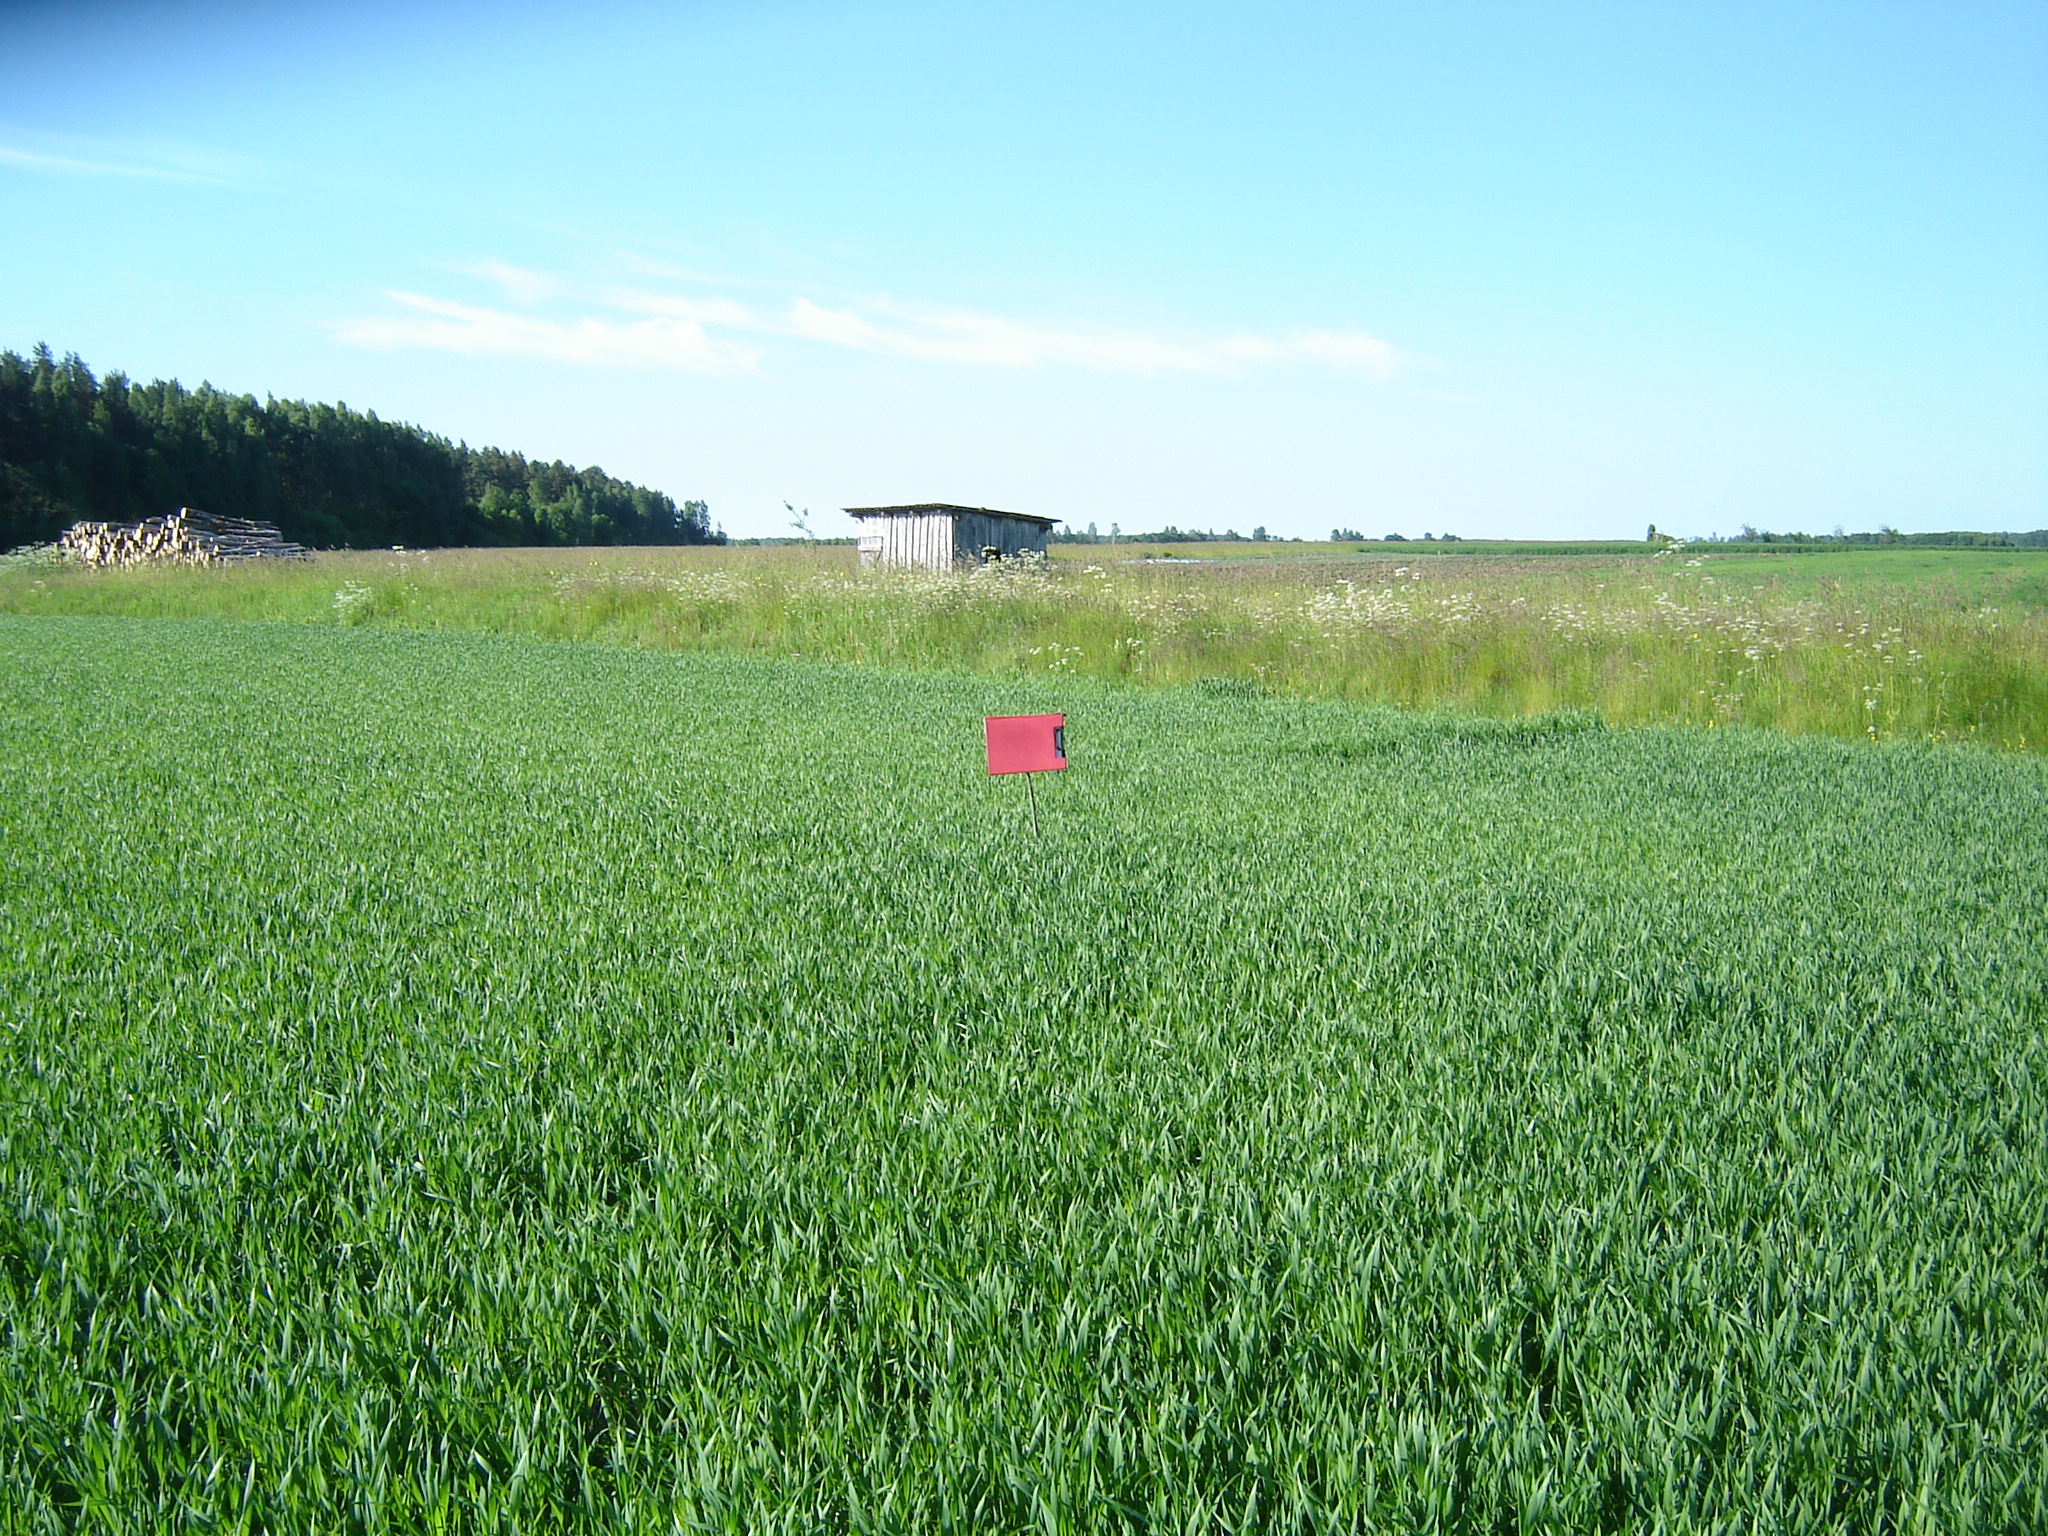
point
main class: Cropland
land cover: Common wheat
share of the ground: > 75 %
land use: Agriculture (excluding fallow land and kitchen gardens)
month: June
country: LT
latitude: 55.5252
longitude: 24.7912
